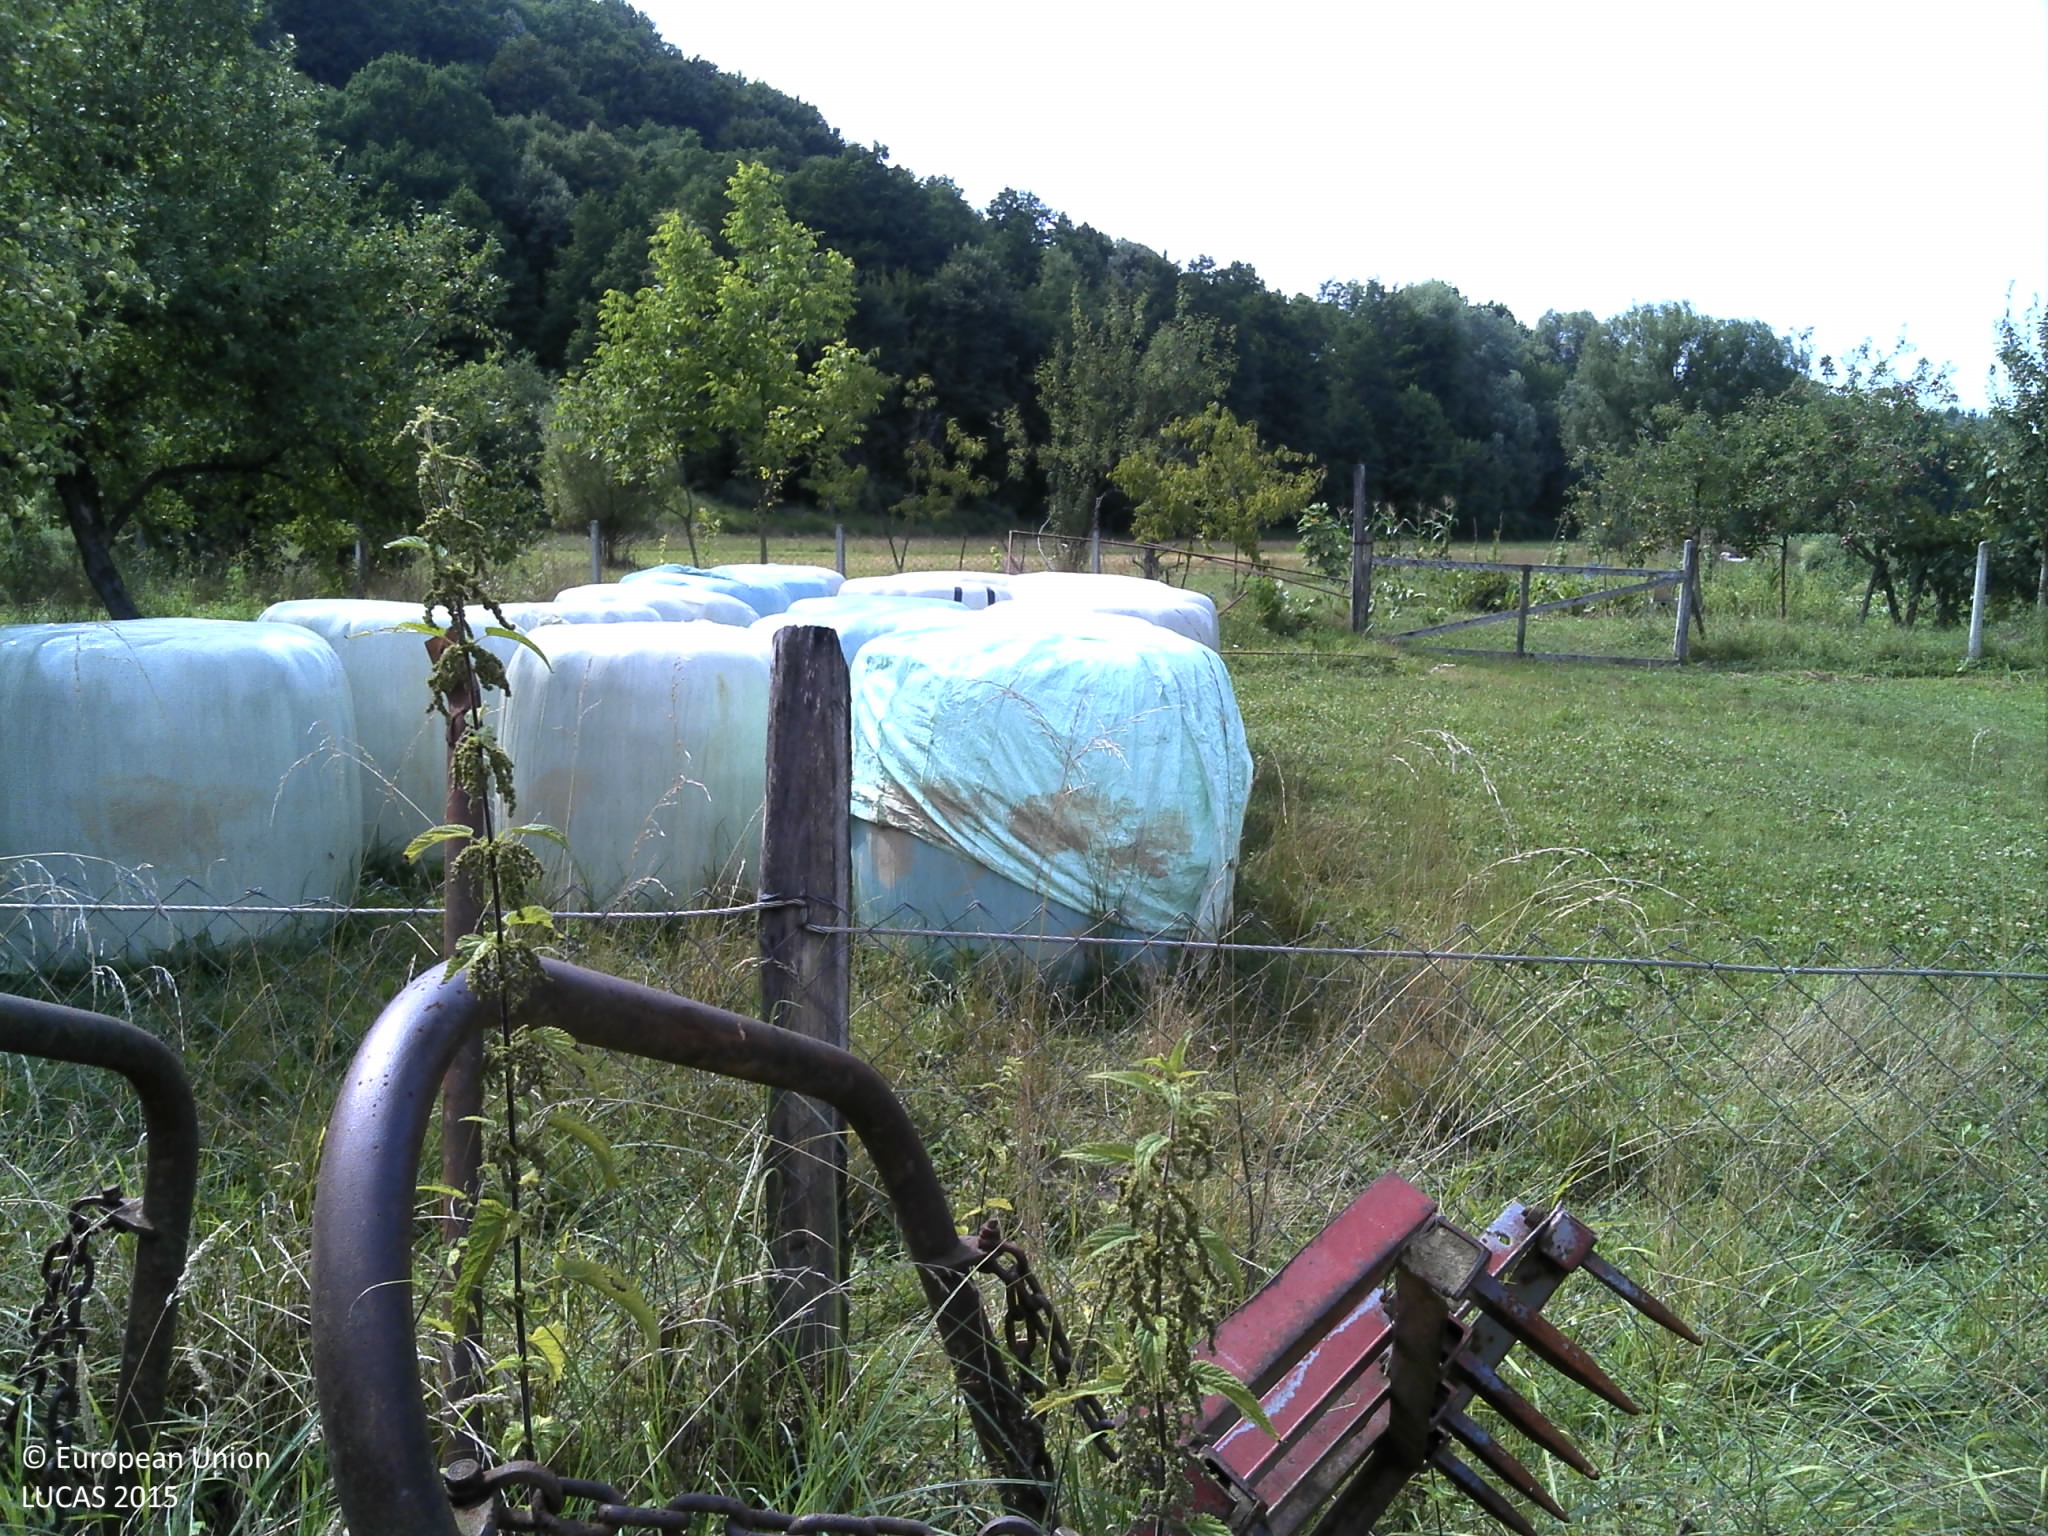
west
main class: Grassland
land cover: Spontaneously vegetated surfaces
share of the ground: > 75 %
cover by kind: herbaceous plants 100 %
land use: Fallow land
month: July
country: HR
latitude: 45.6511
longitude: 17.2769
